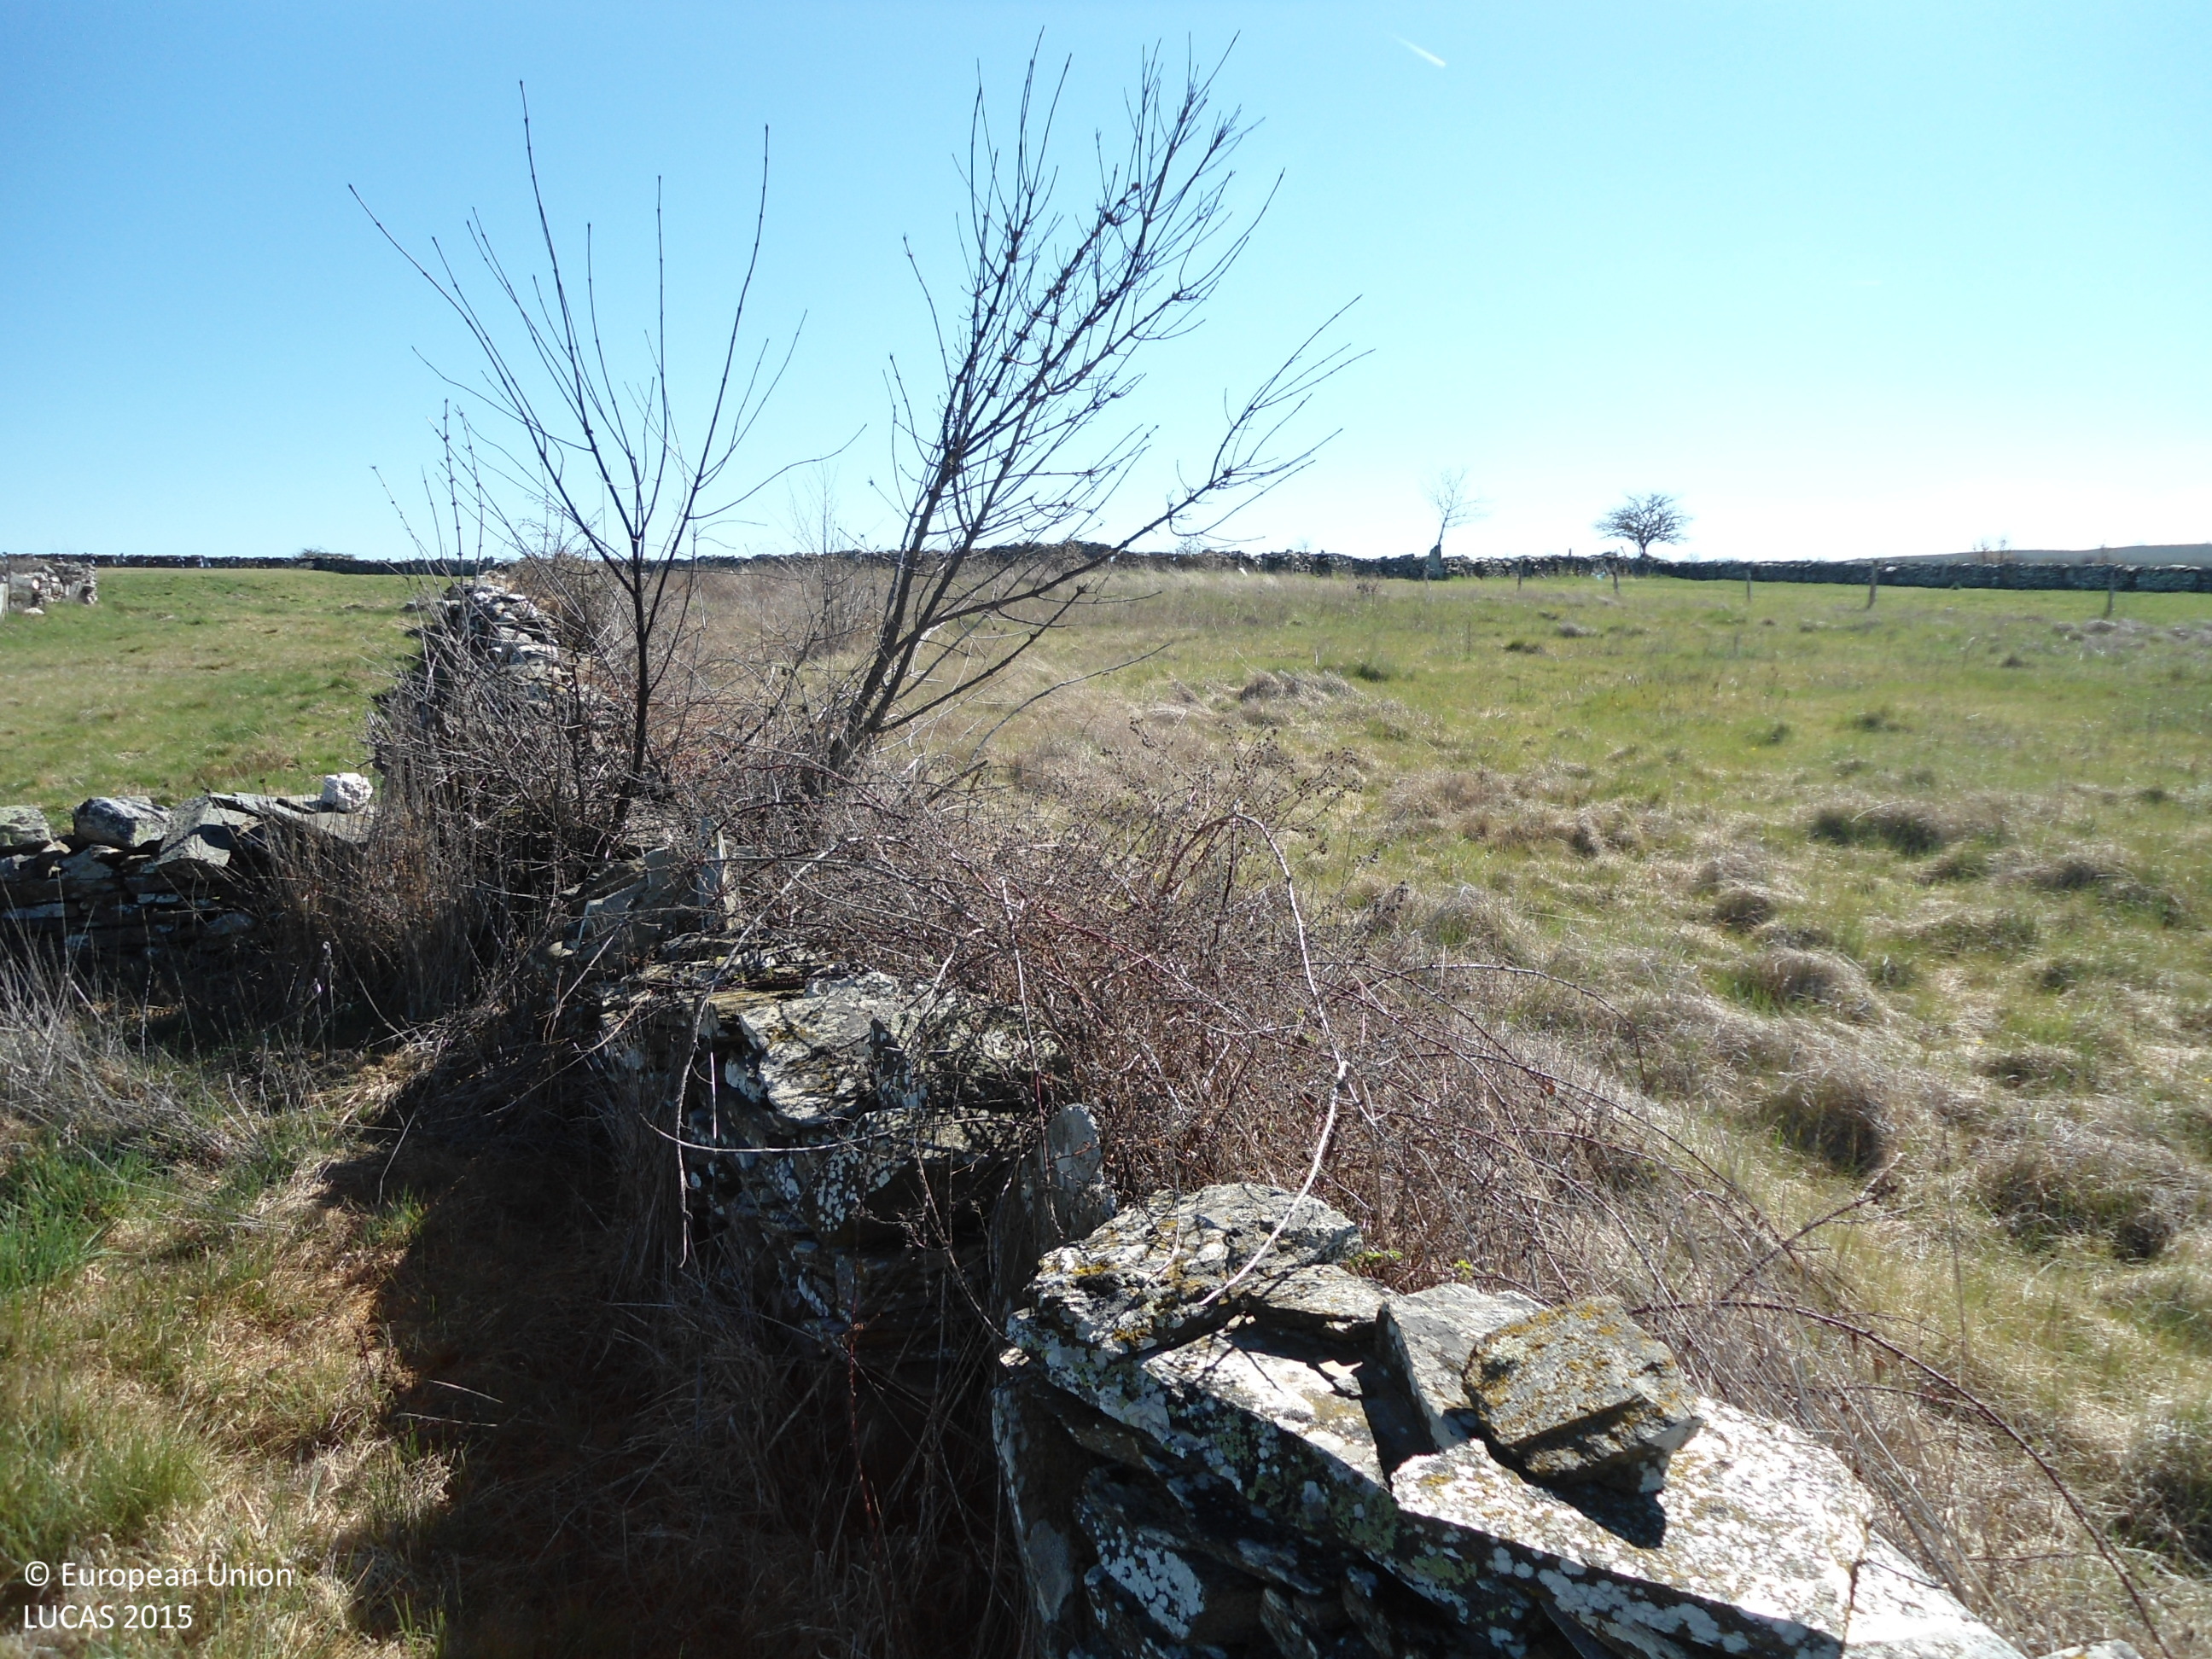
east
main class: Grassland
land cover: Grassland without tree/shrub cover
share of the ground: > 75 %
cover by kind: herbaceous plants 100 %
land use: Agriculture (excluding fallow land and kitchen gardens)
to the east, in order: Grassland without tree/shrub cover; Dry stone walls; Grassland without tree/shrub cover; Dry stone walls; Grassland without tree/shrub cover; Dry stone walls; Grassland without tree/shrub cover; Dry stone walls; Grassland without tree/shrub cover; Dry stone walls; Grassland without tree/shrub cover; Dry stone walls; Grass margins; Tracks; Spontaneously vegetated surfaces; Grassland without tree/shrub cover; Other bare soil; Grassland without tree/shrub cover; Oats
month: April
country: ES
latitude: 41.7012
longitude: -6.2382
